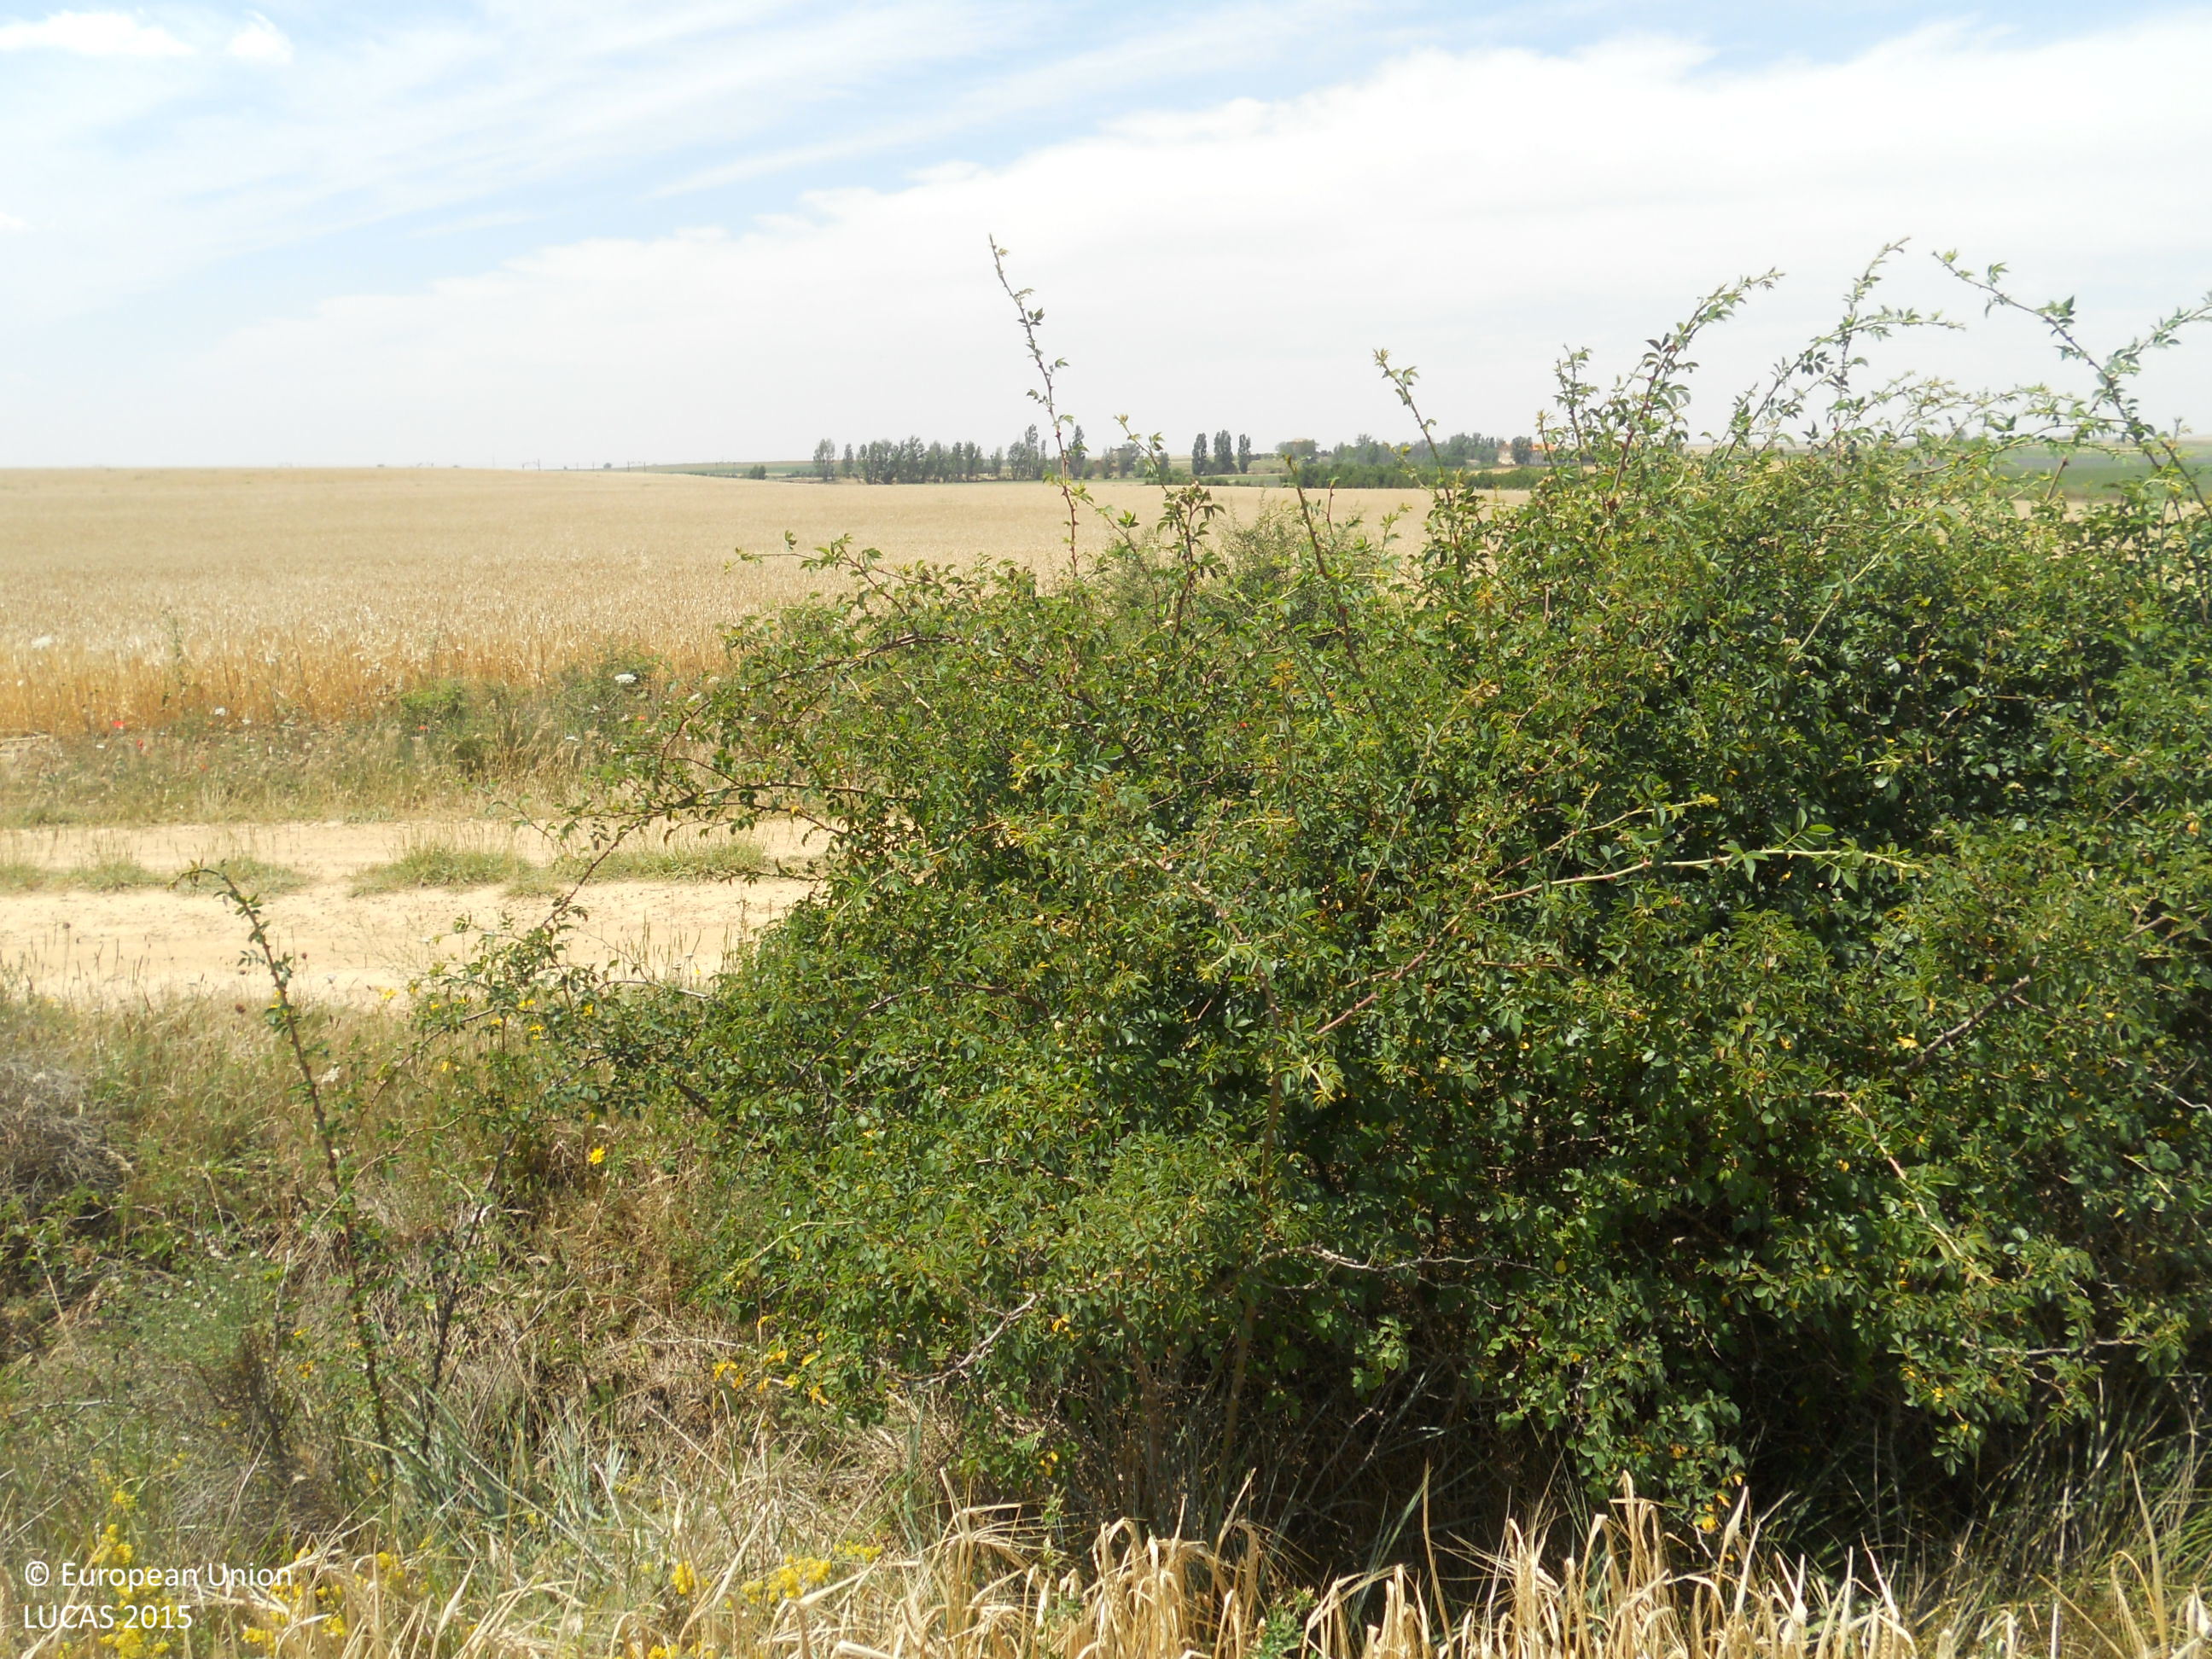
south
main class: Cropland
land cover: Barley
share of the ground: > 75 %
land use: Agriculture (excluding fallow land and kitchen gardens)
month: July
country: ES
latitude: 42.1955
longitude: -4.8399
